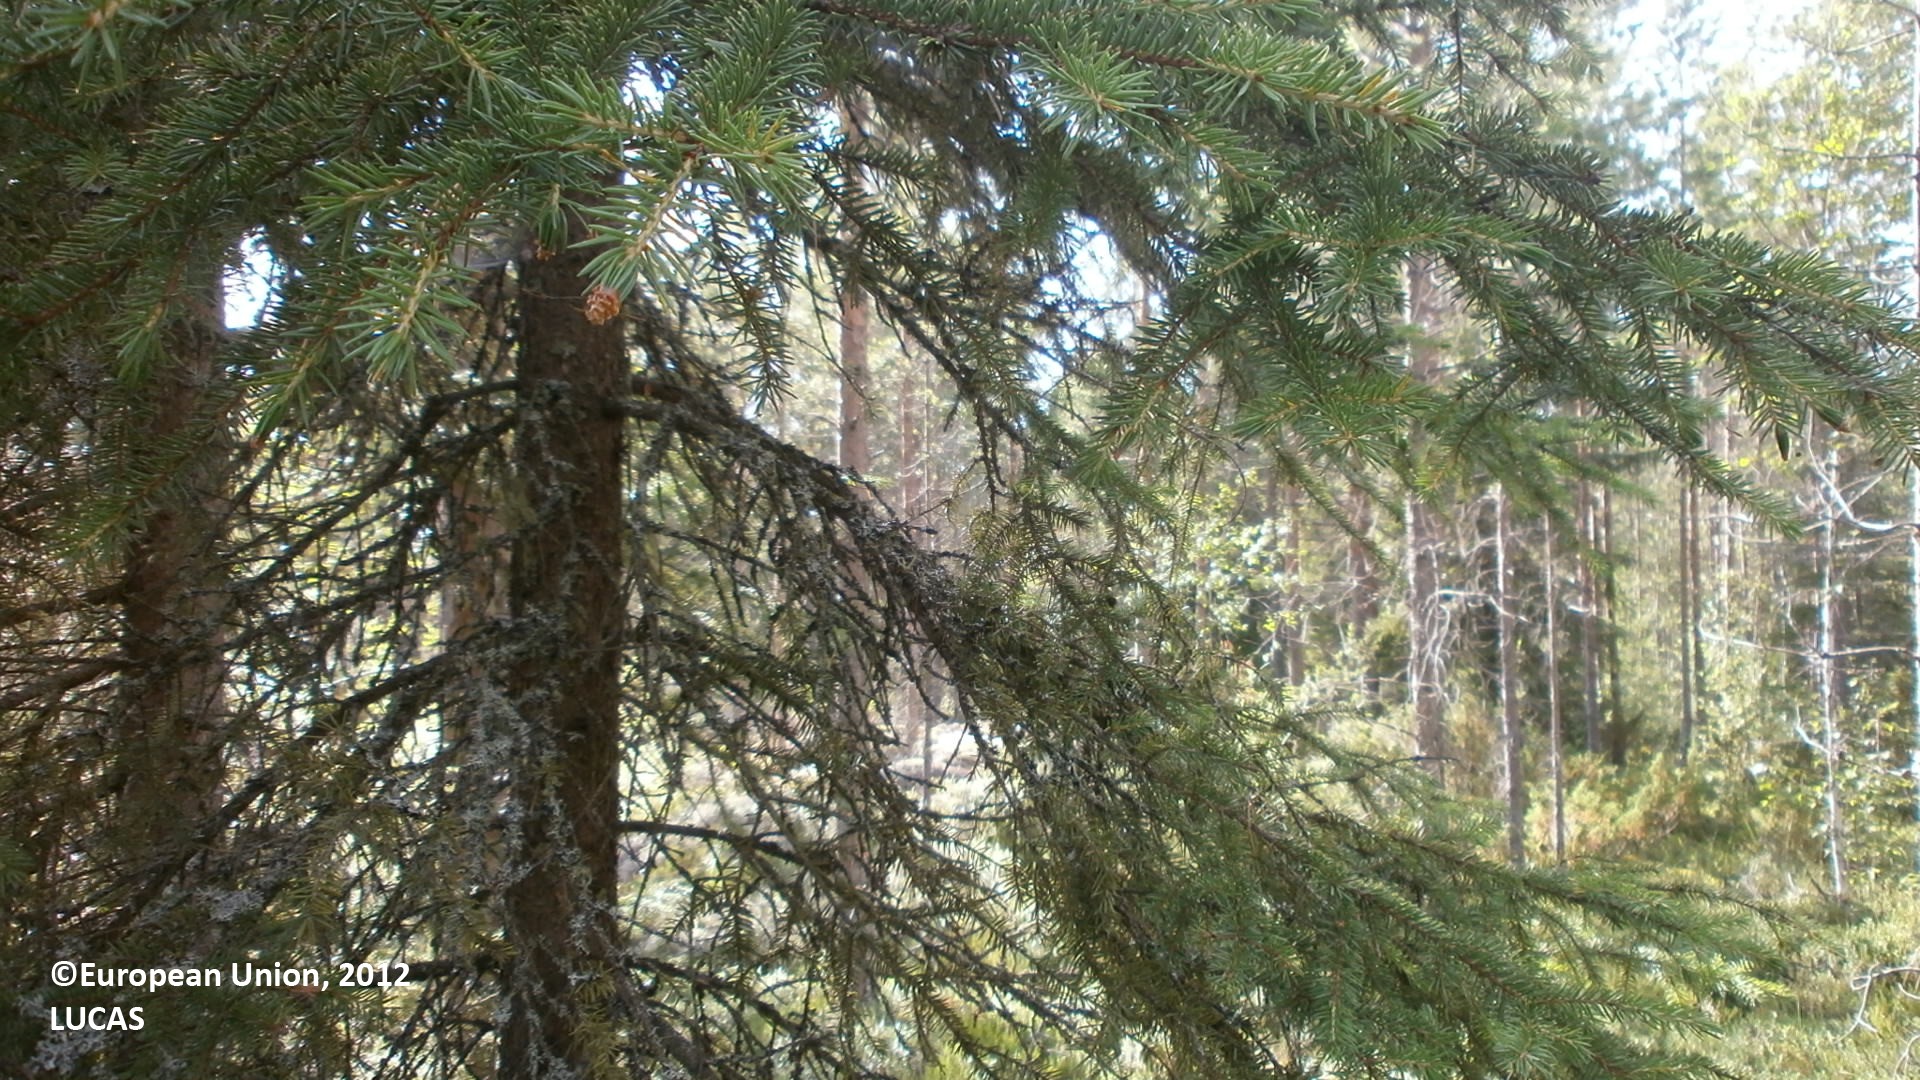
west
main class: Woodland
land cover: Pine dominated coniferous woodland
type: boreal forest
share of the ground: 50 - 75 %
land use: Forestry
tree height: > 5 m
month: July
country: FI
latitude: 64.1814
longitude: 24.3729
